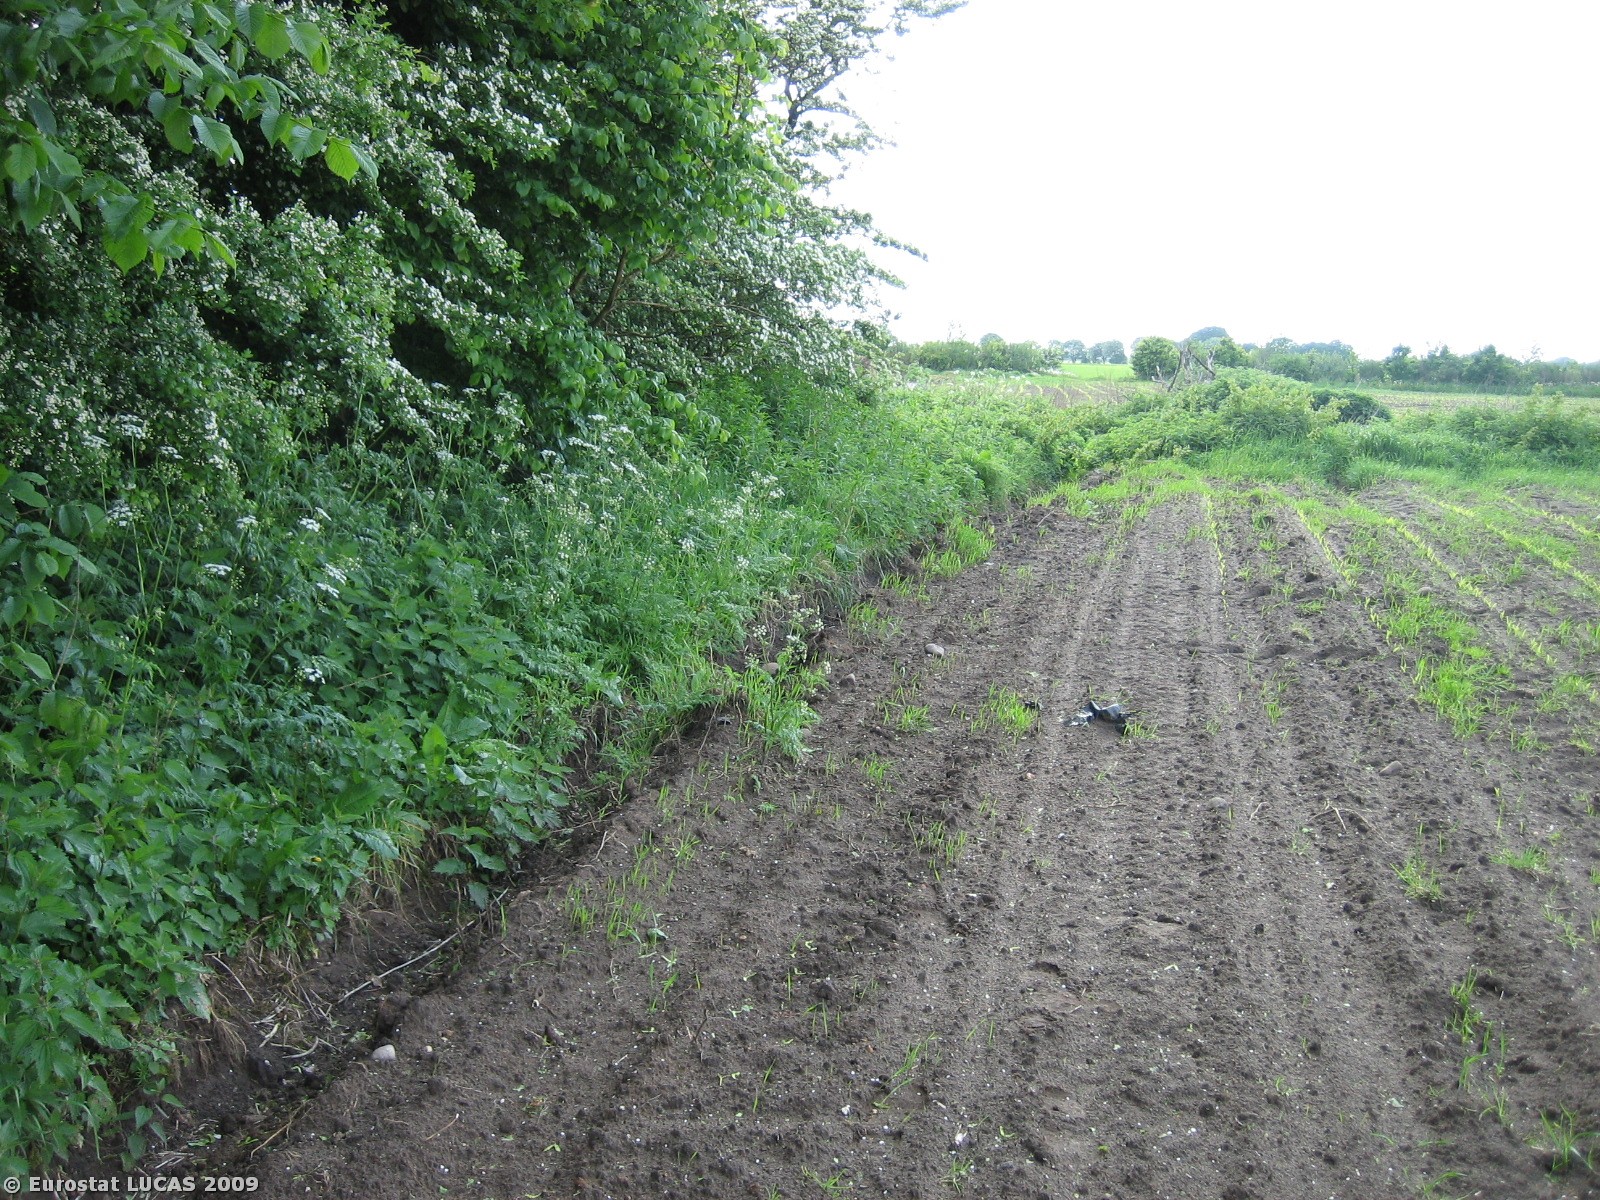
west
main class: Cropland
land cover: Maize
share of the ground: < 10 %
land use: Agriculture (excluding fallow land and kitchen gardens)
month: May
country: DK
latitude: 56.0934
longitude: 8.9243
